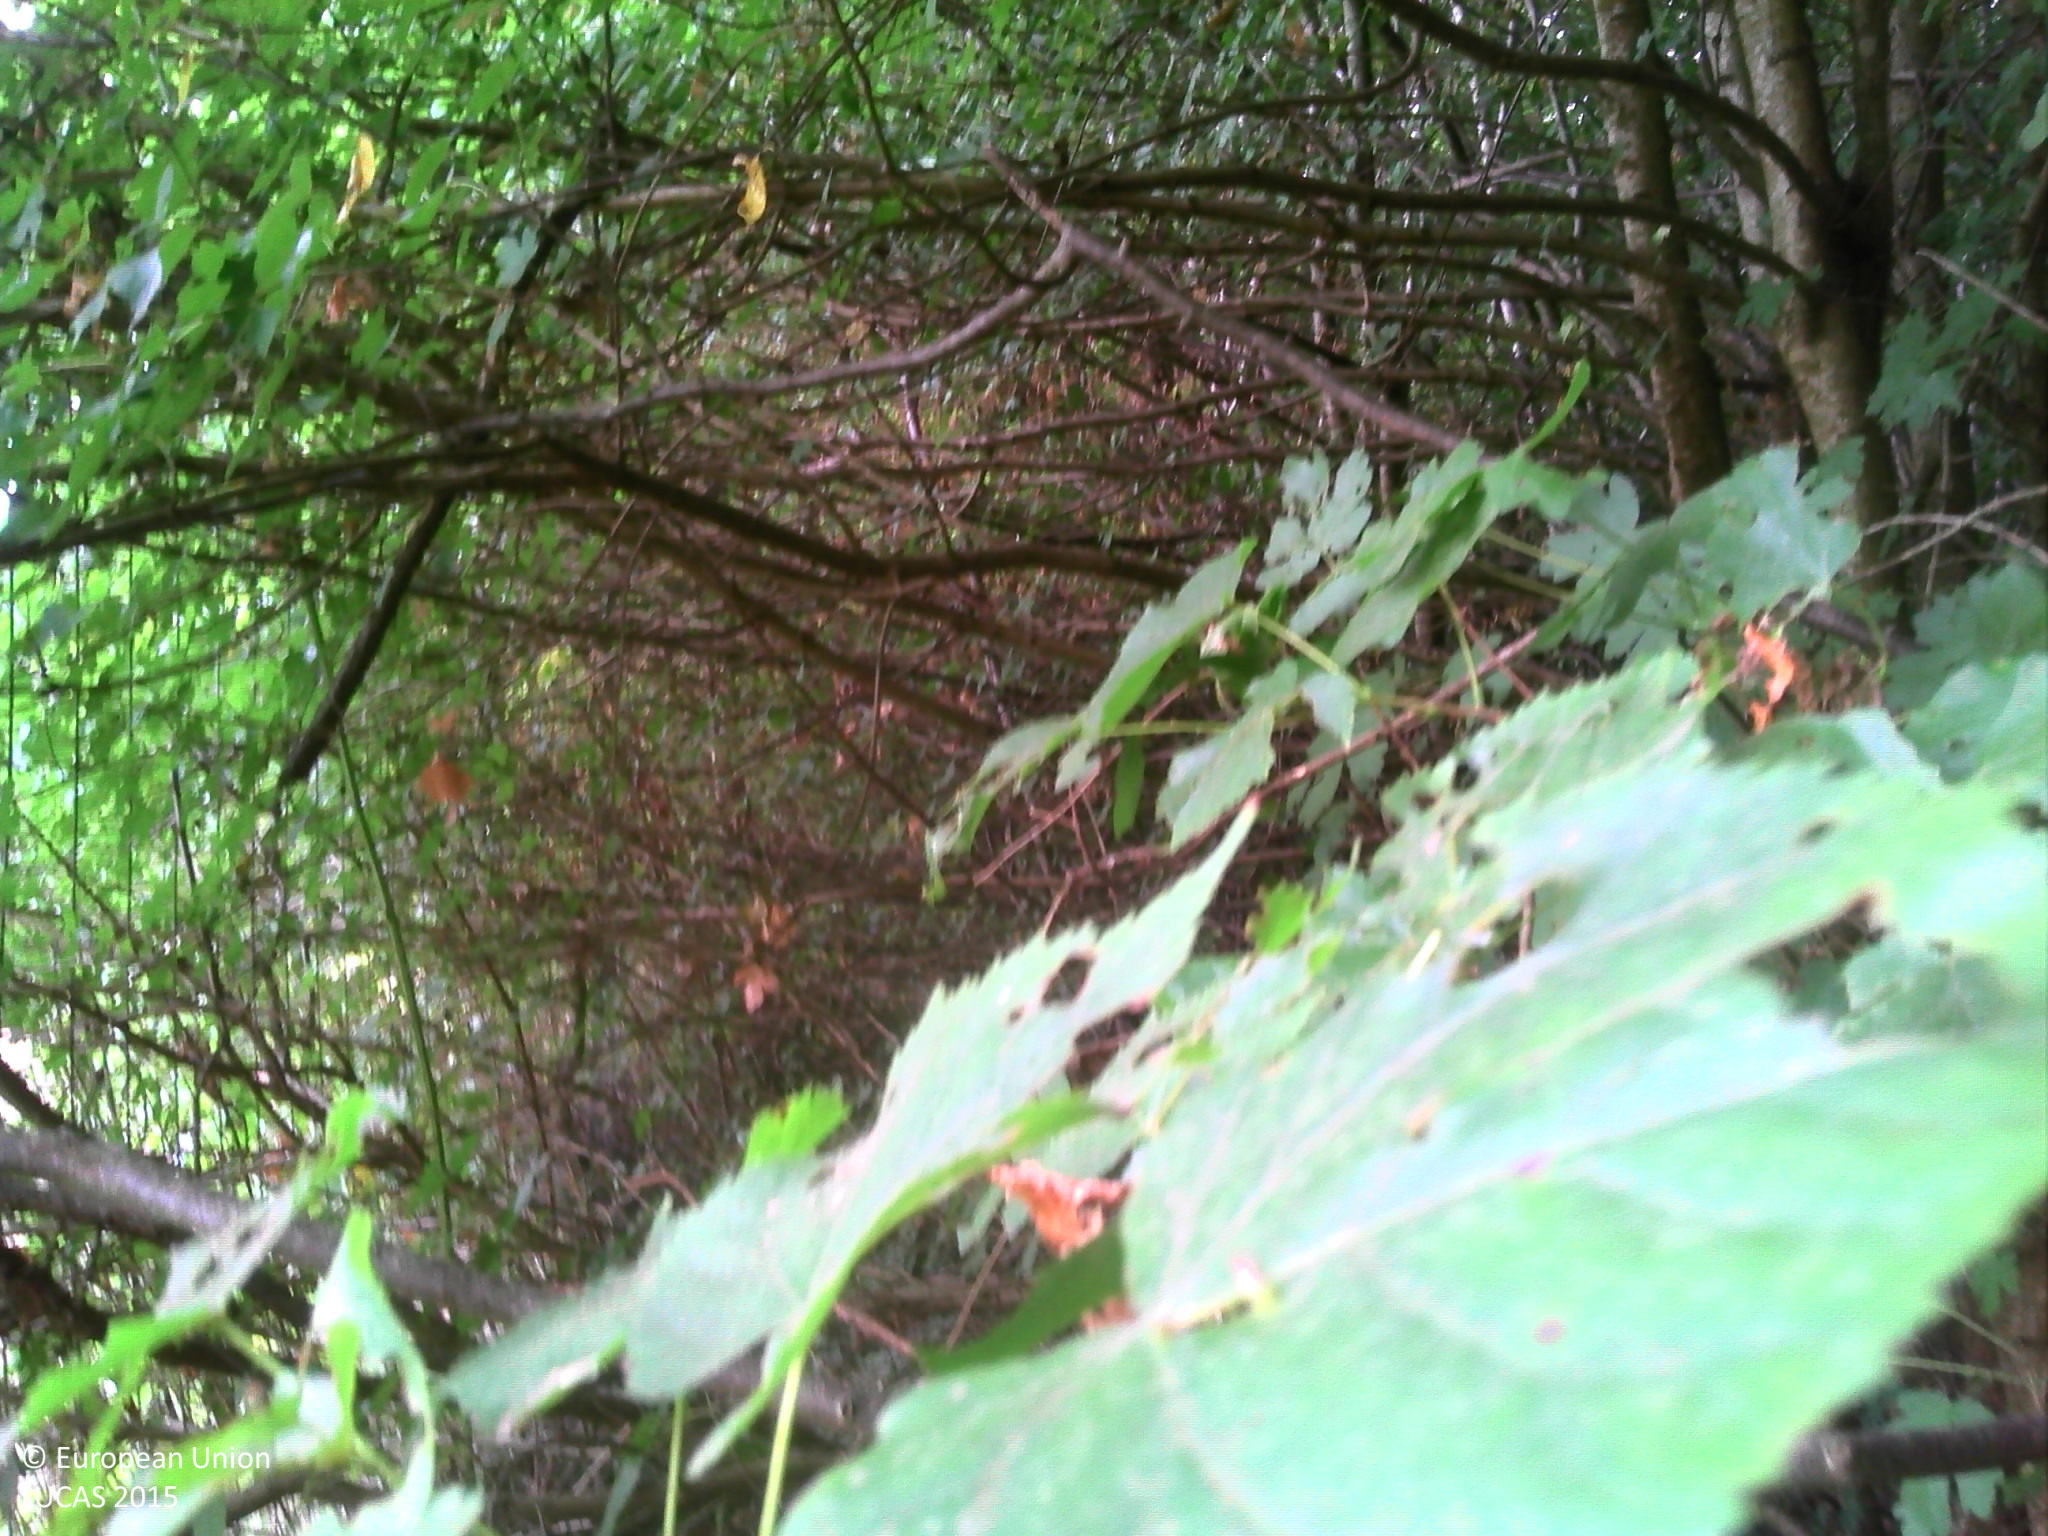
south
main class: Grassland
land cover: Spontaneously vegetated surfaces
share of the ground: > 75 %
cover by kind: herbaceous plants 100 %
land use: Road transport
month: July
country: FR
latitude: 46.8753
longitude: 4.8184
